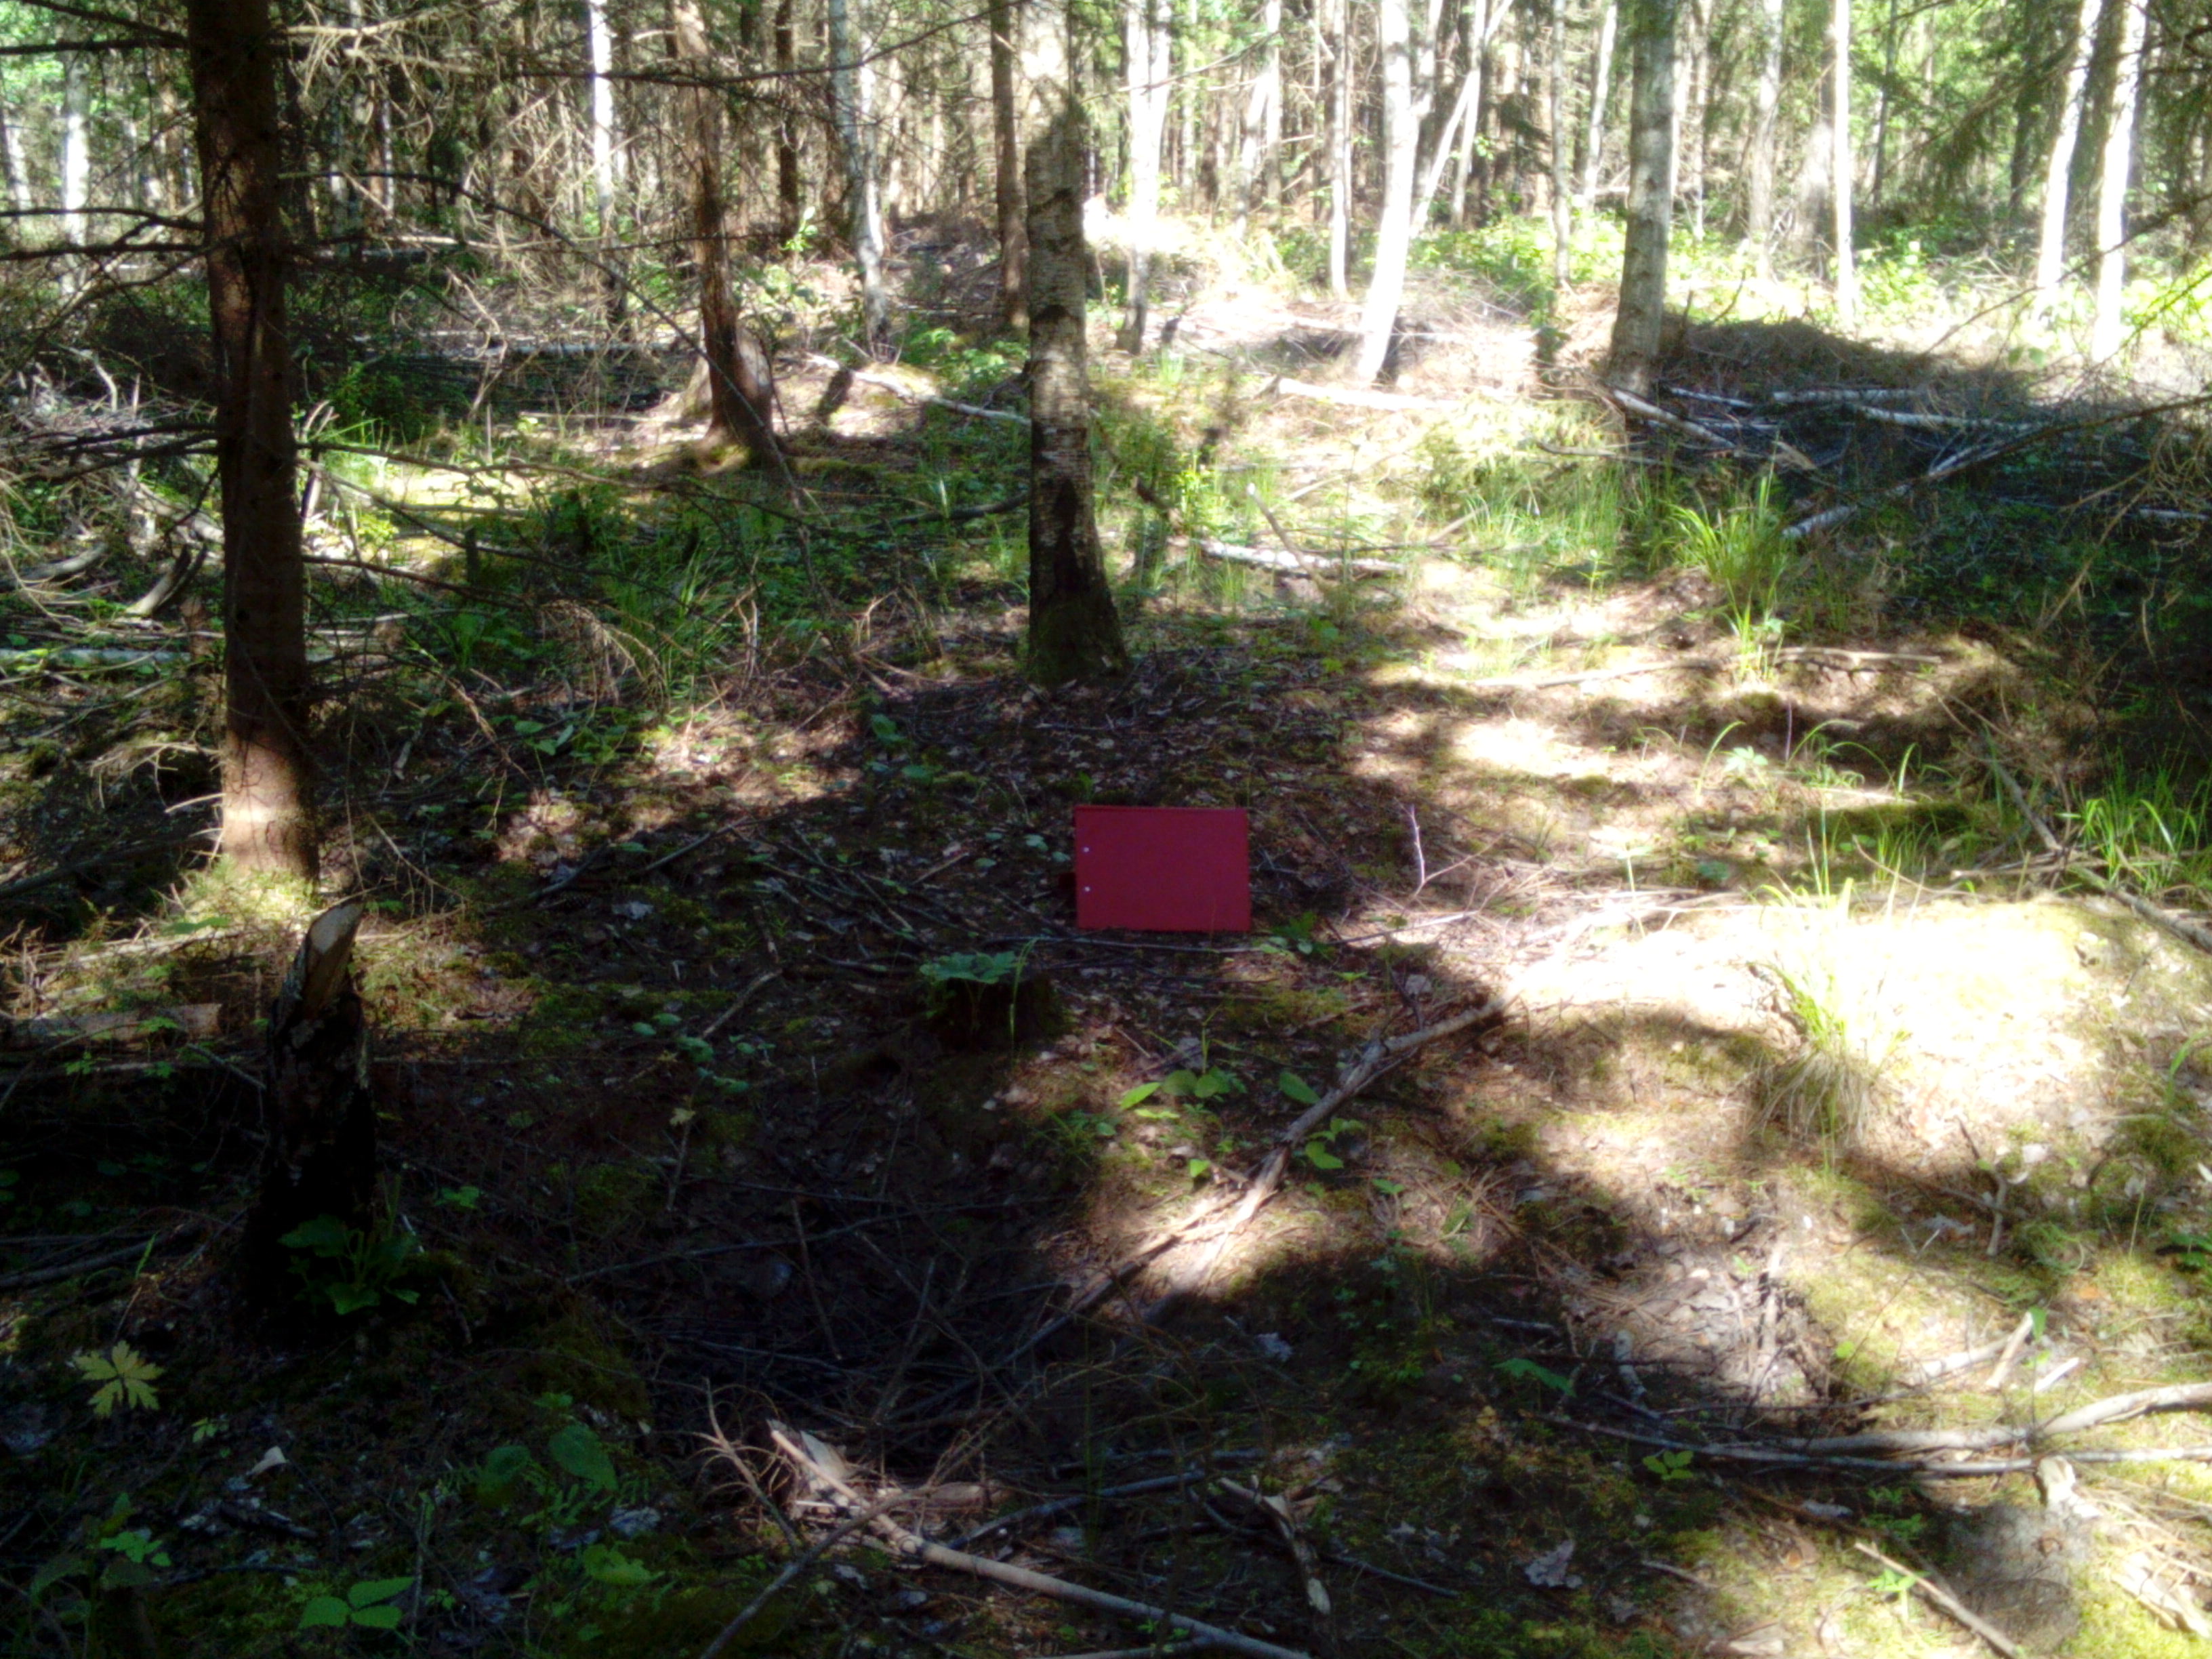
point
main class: Woodland
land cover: Spruce dominated mixed woodland
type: hemiboreal forest and nemoral coniferous forest and mixed broadleaved-coniferous forest
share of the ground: > 75 %
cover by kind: coniferous forest trees 50 %, broadleaved forest trees 35 %, herbaceous plants 5 %, lichens and mosses 5 %, unconsolidated bare surface 5 %
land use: Forestry
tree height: > 5 m
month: July
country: LV
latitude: 56.5586
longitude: 22.1072
